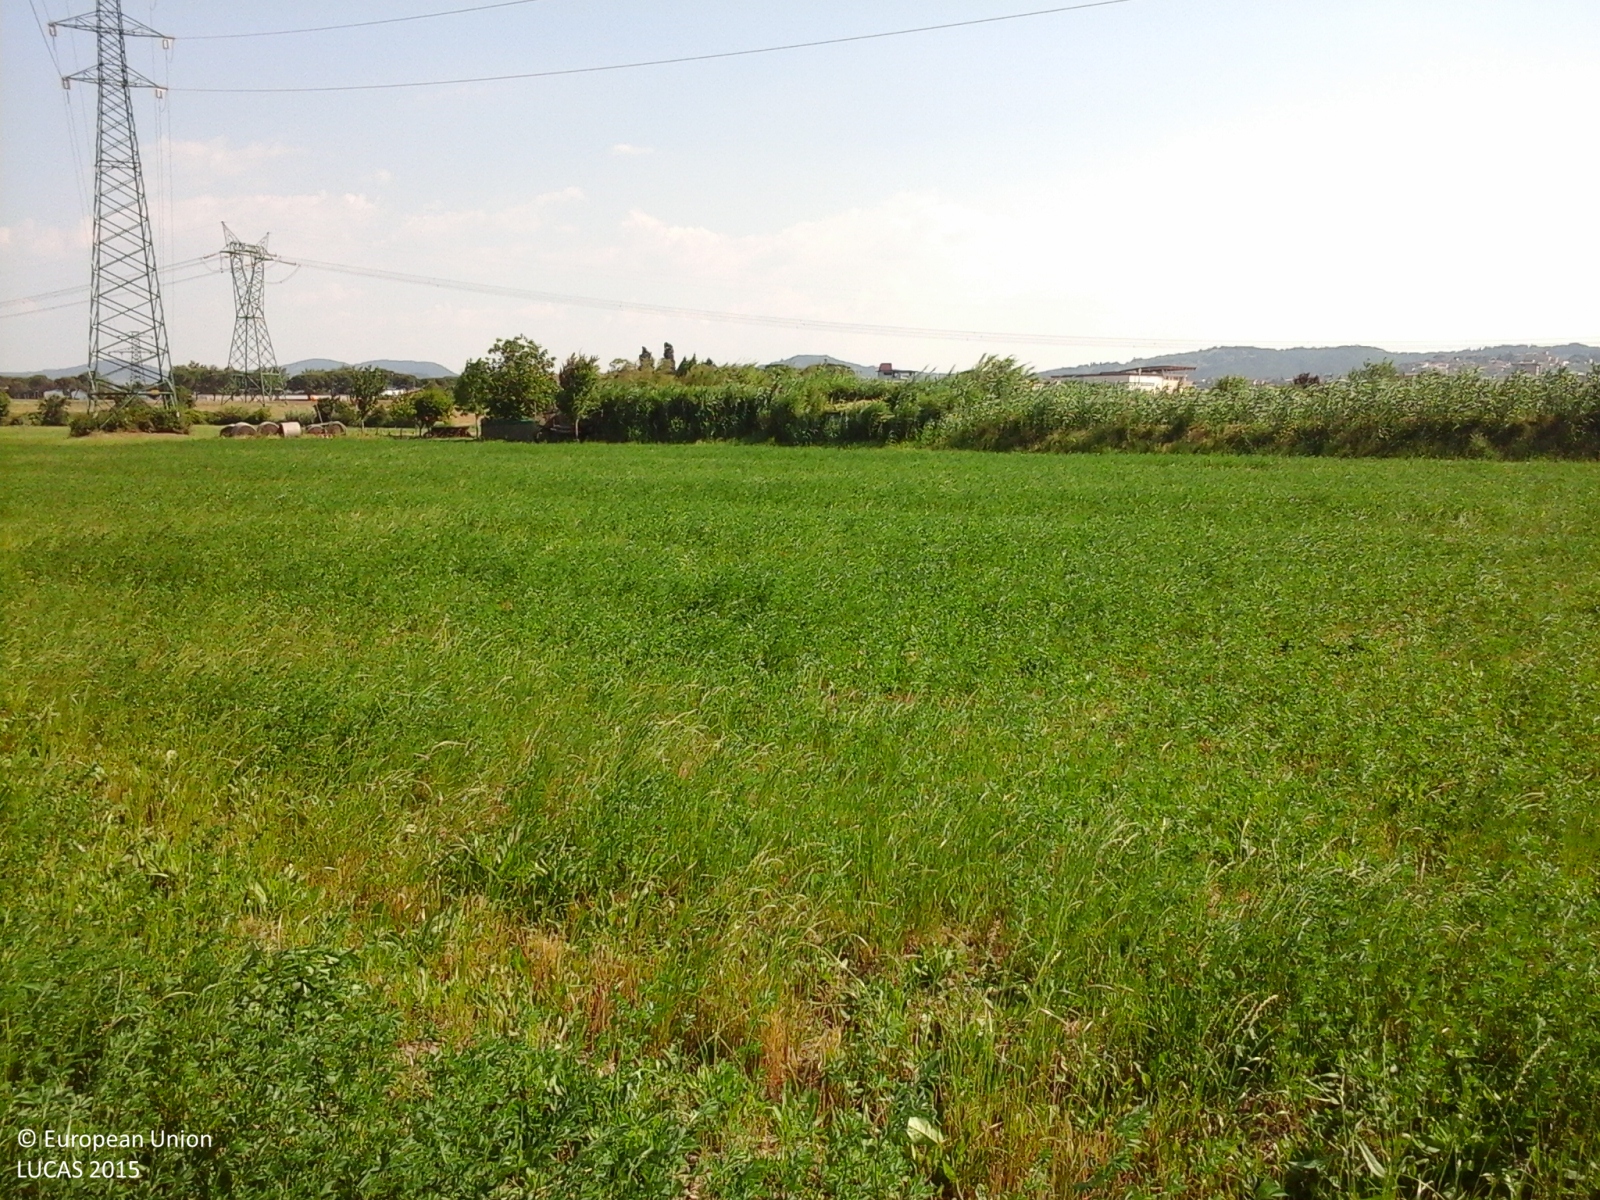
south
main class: Cropland
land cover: Lucerne
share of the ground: > 75 %
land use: Agriculture (excluding fallow land and kitchen gardens)
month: June
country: IT
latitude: 43.8034
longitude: 11.1034
